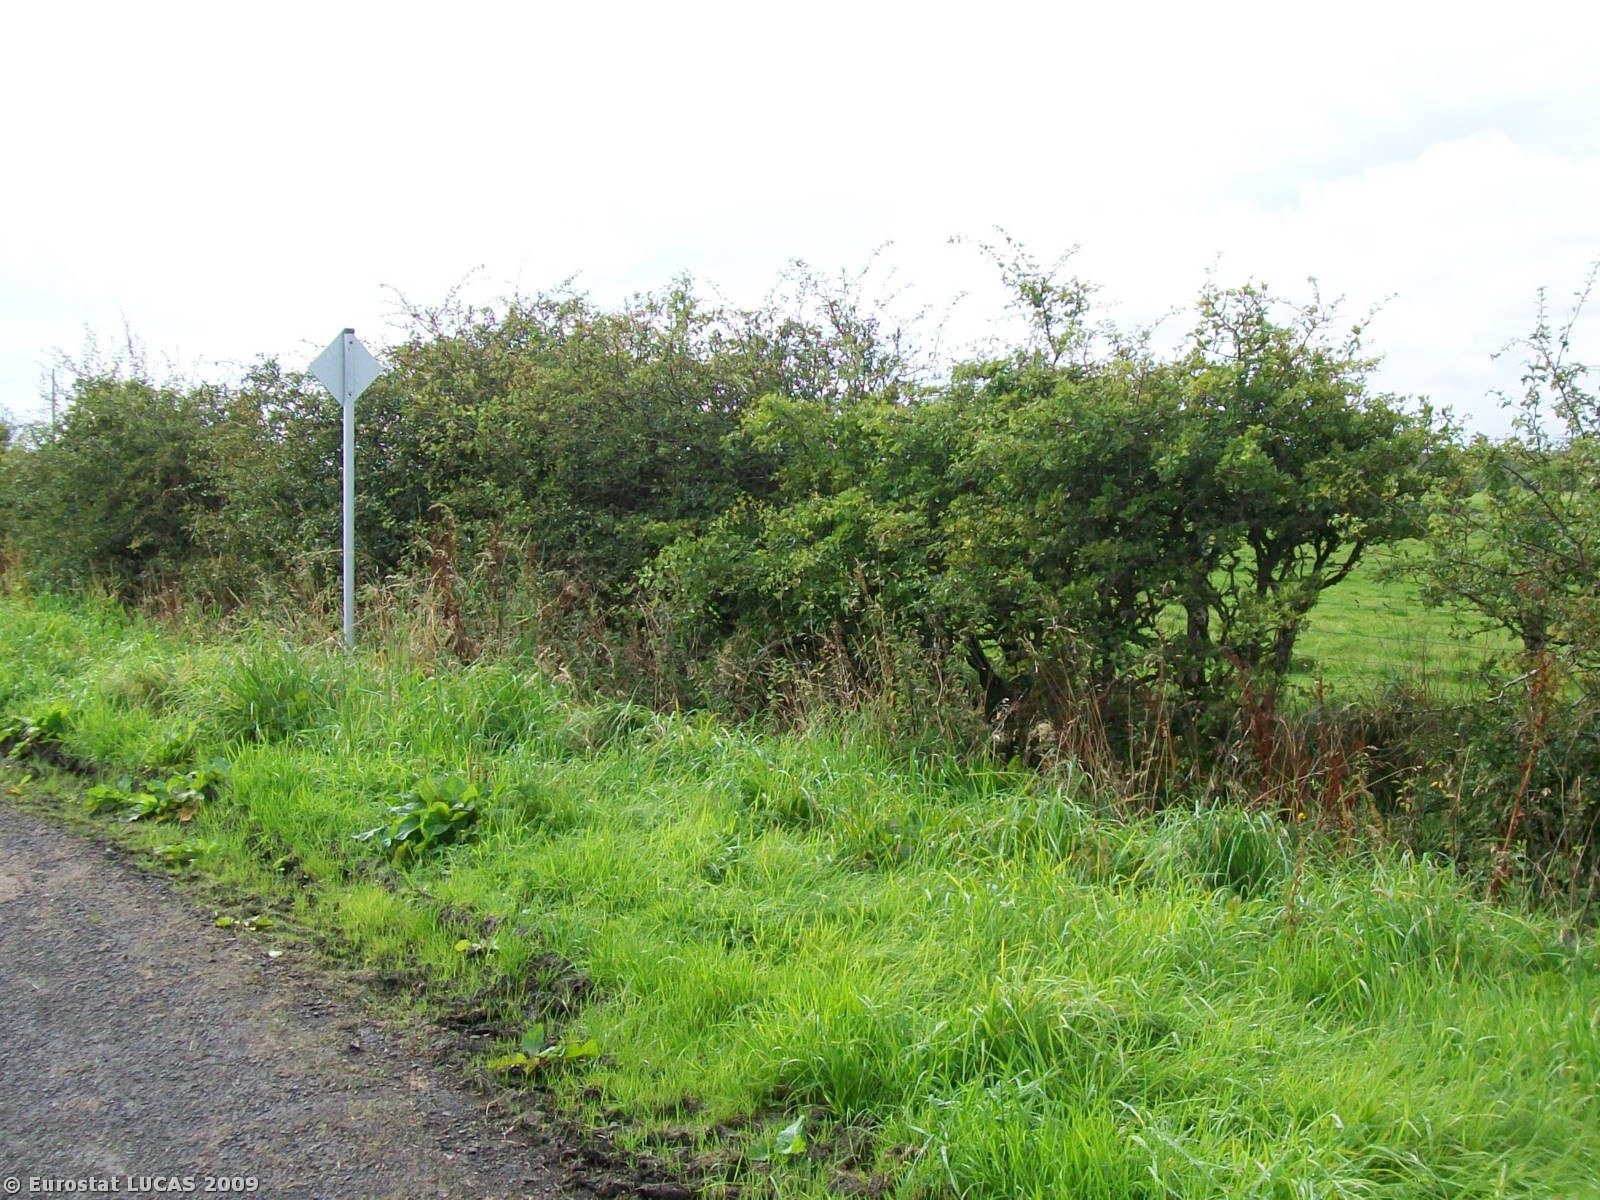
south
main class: Grassland
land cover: Grassland without tree/shrub cover
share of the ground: > 75 %
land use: Agriculture (excluding fallow land and kitchen gardens)
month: August
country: GB
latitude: 58.4526
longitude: -3.2727
